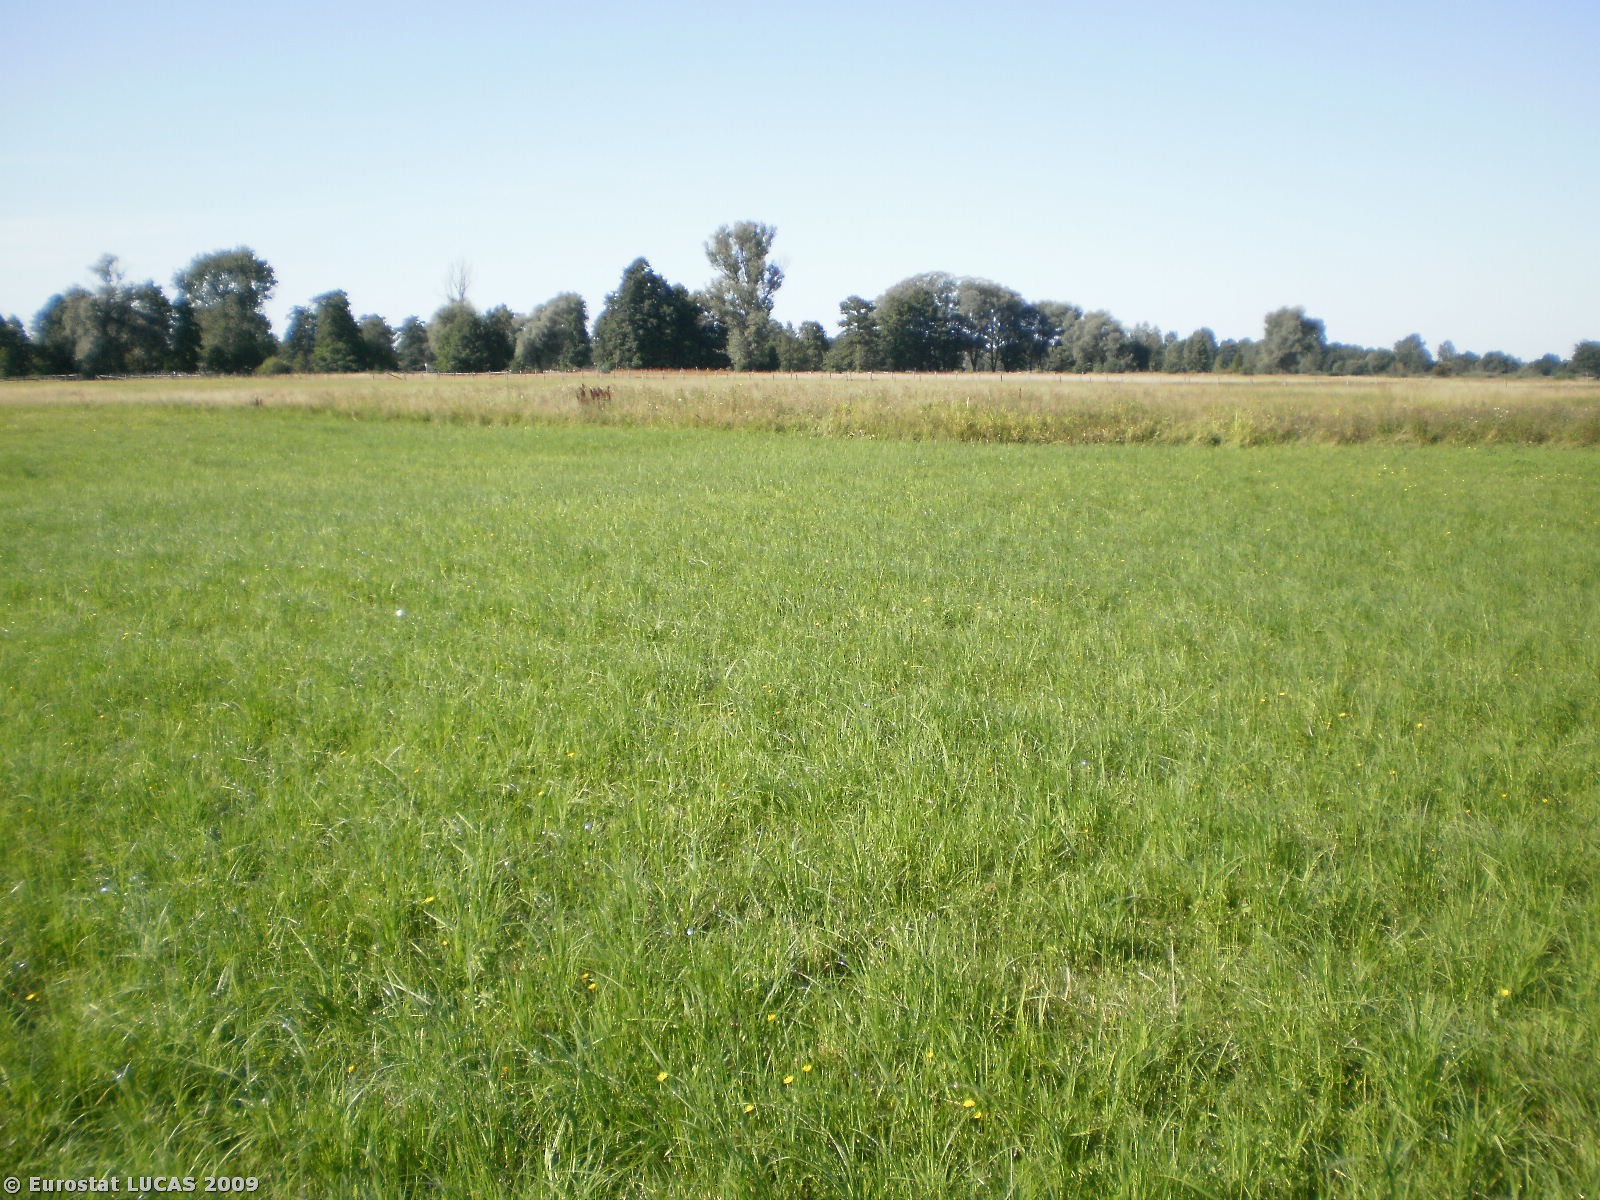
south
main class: Grassland
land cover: Grassland without tree/shrub cover
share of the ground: > 75 %
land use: Agriculture (excluding fallow land and kitchen gardens)
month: August
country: PL
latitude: 52.6137
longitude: 21.7065
